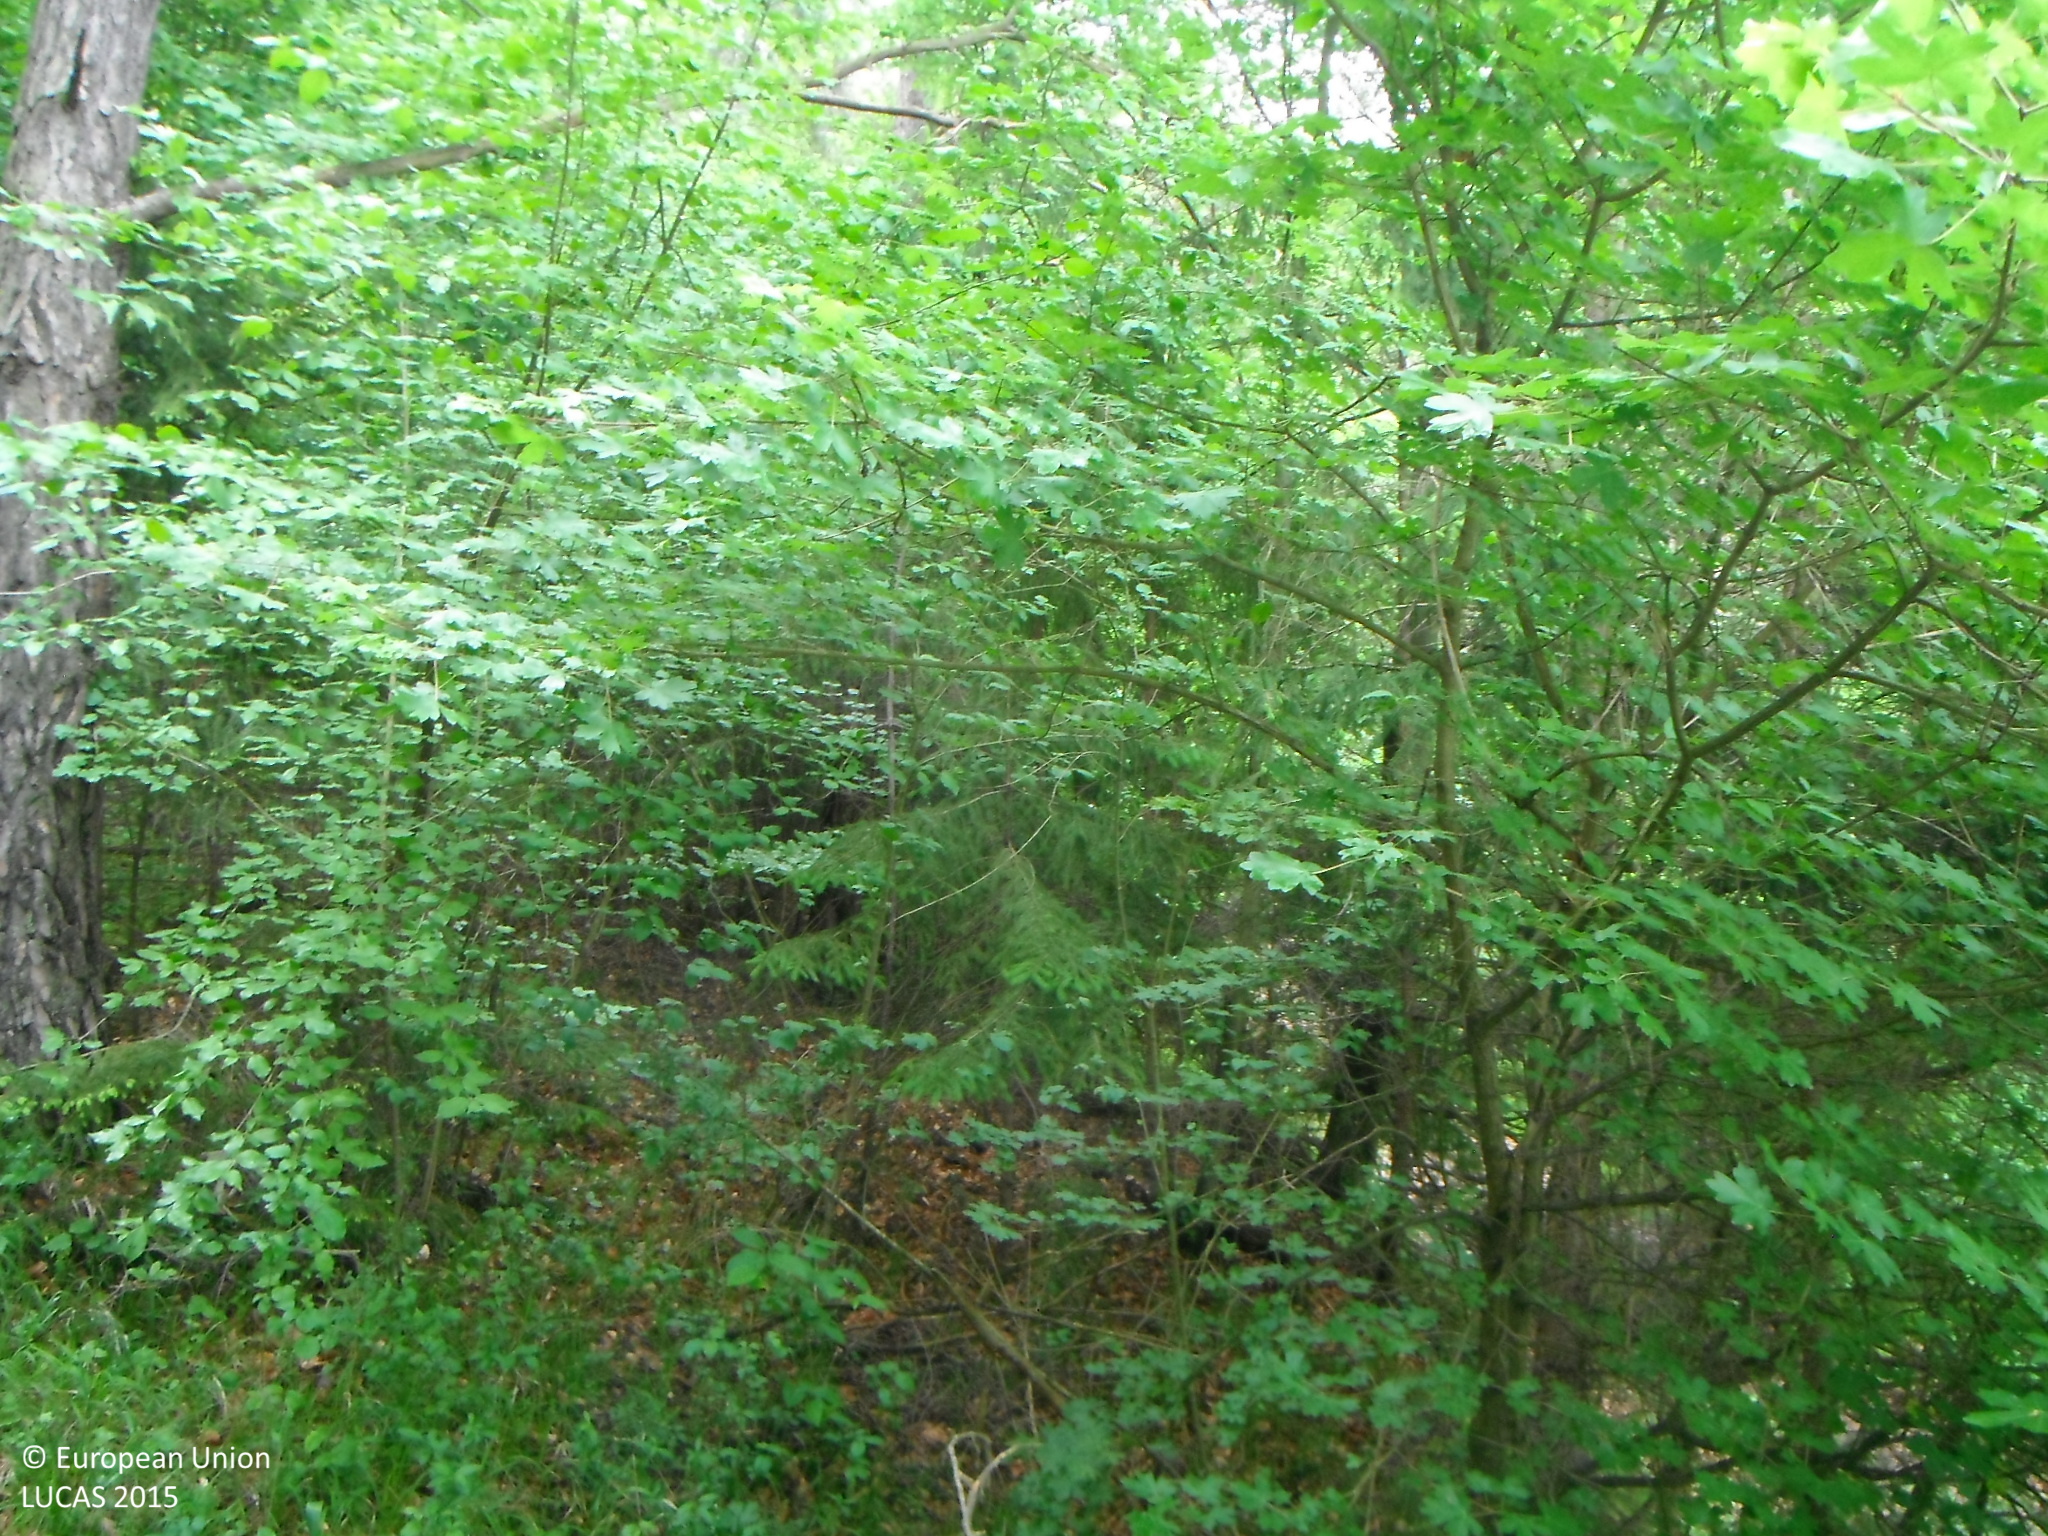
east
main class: Woodland
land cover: Pine dominated mixed woodland
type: hemiboreal forest and nemoral coniferous forest and mixed broadleaved-coniferous forest
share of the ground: > 75 %
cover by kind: coniferous forest trees 75 %, broadleaved forest trees 25 %
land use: Forestry
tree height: > 5 m
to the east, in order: Pine dominated mixed woodland; Broadleaved woodland; Tracks; Pine dominated mixed woodland
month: May
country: SK
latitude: 48.7790
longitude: 19.2087
